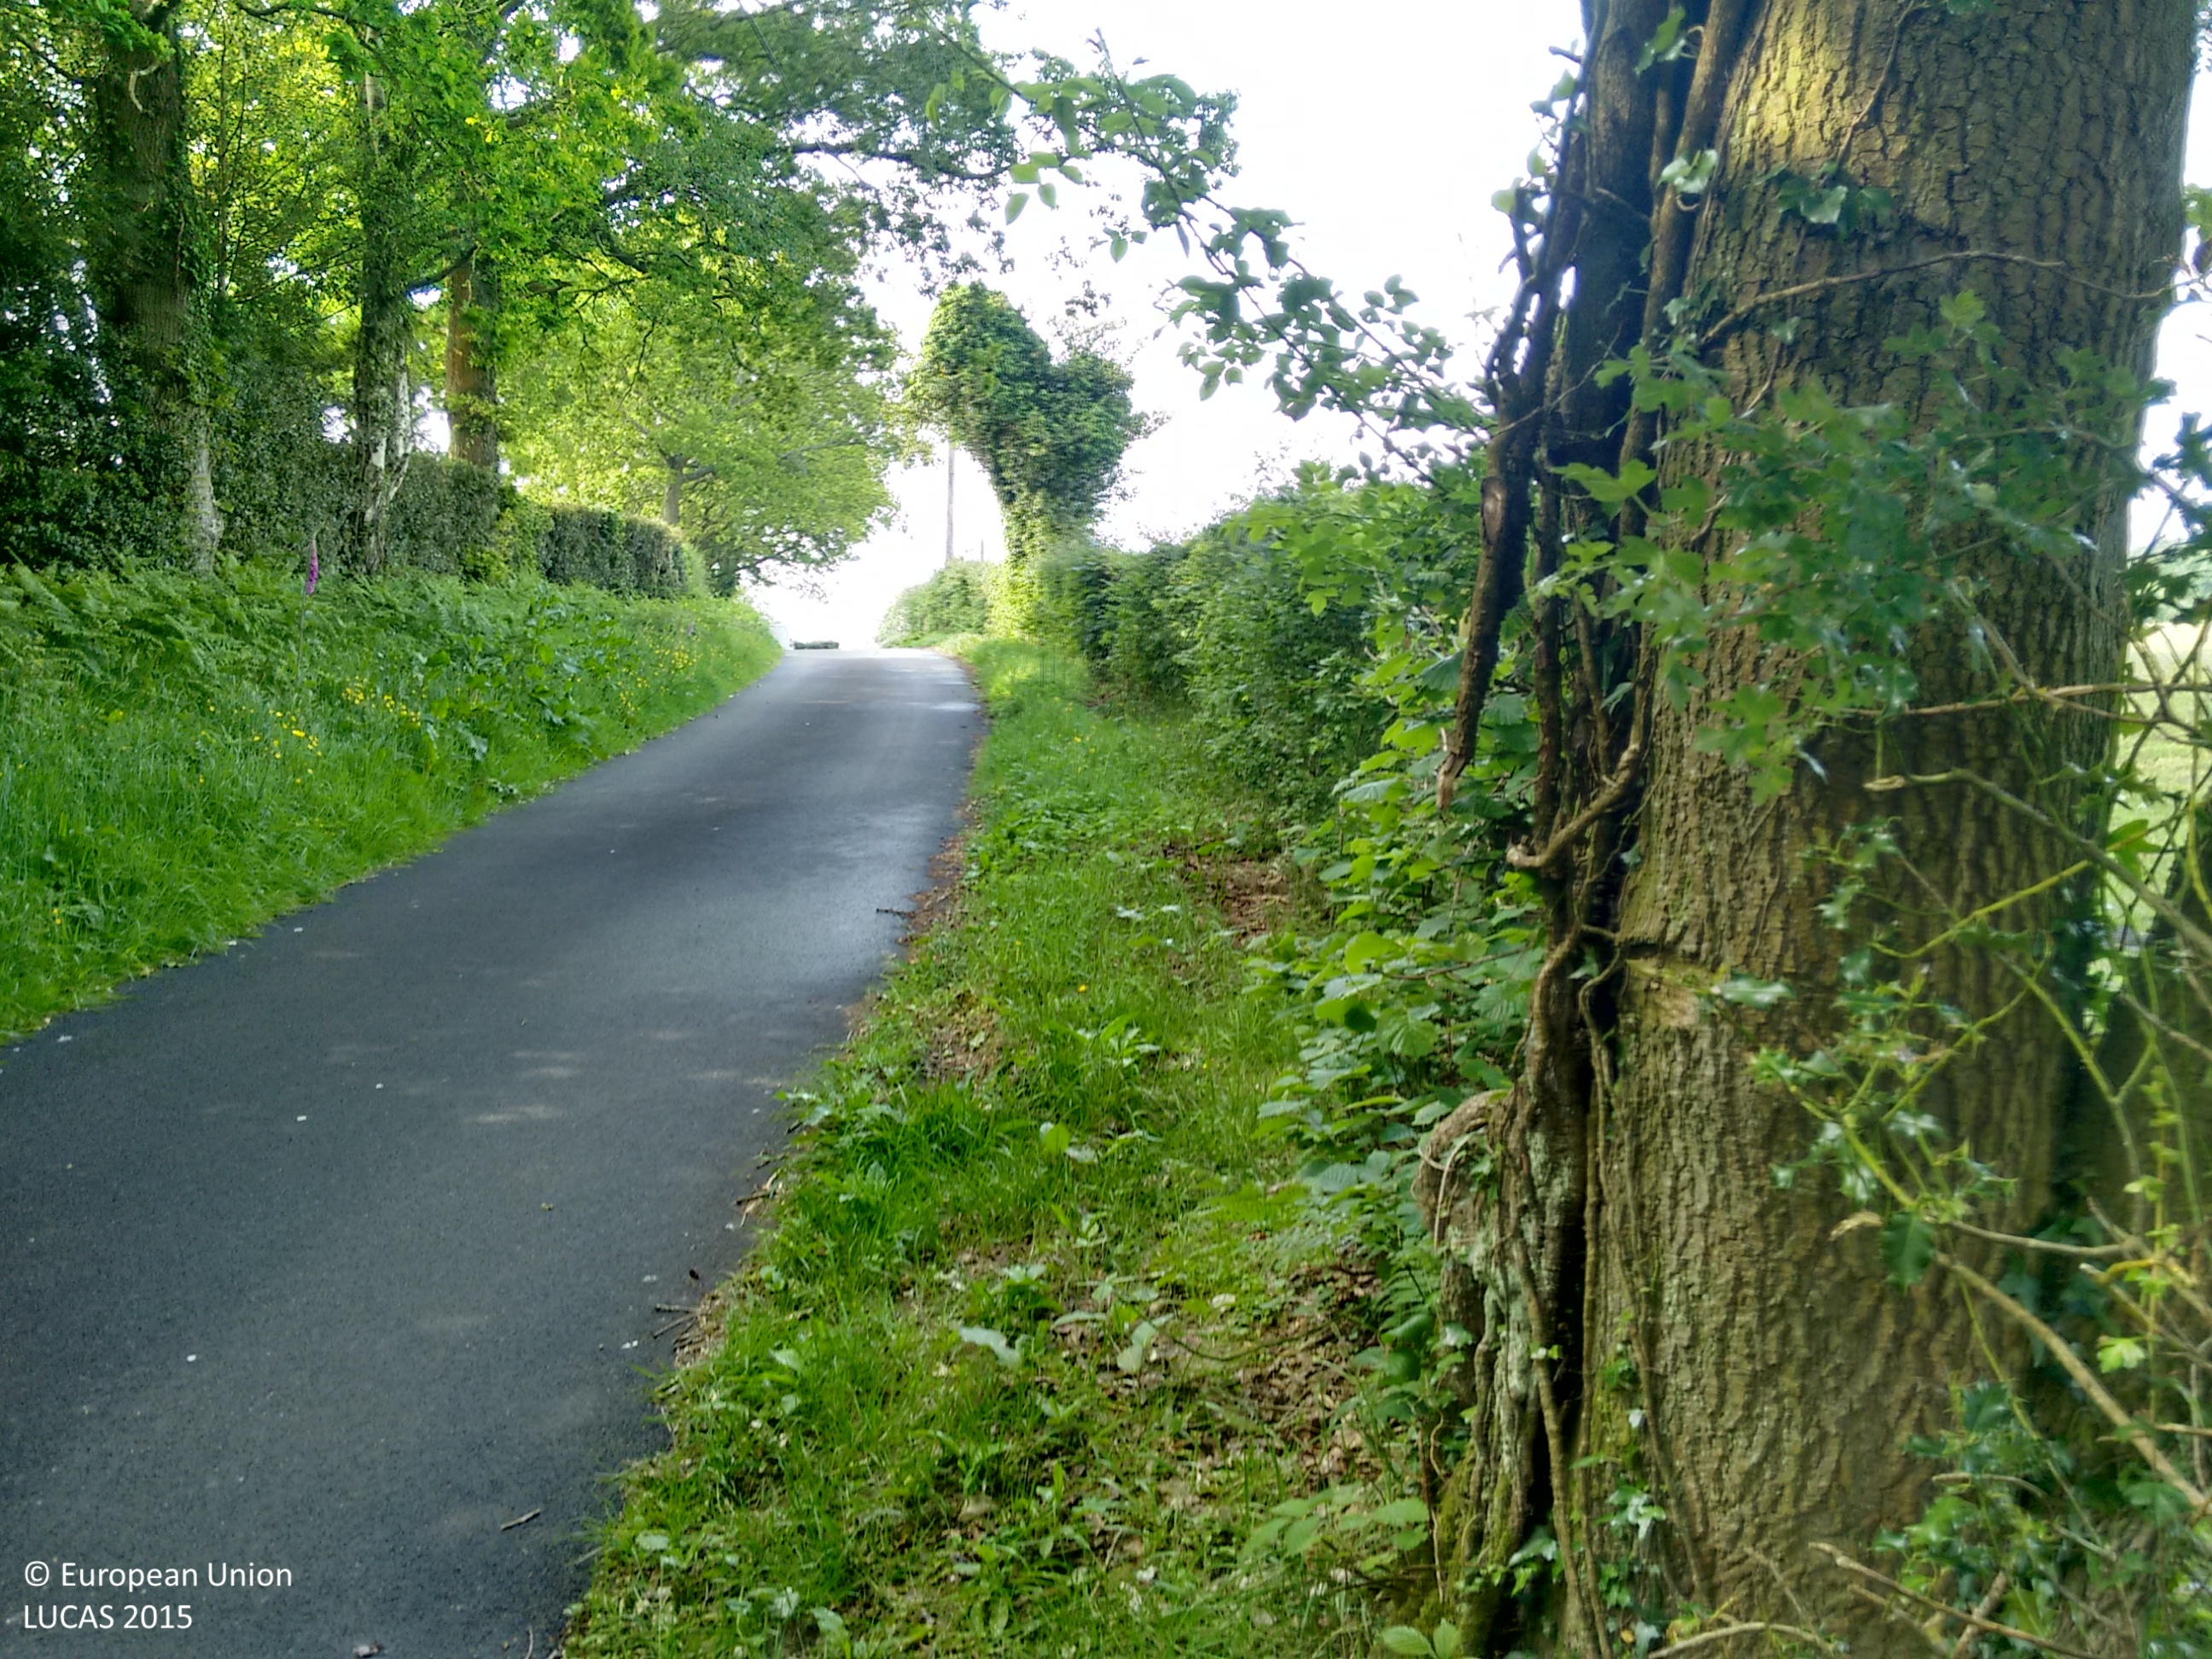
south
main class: Grassland
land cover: Grassland with sparse tree/shrub cover
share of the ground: > 75 %
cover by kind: herbaceous plants 95 %, broadleaved forest trees 5 %
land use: Agriculture (excluding fallow land and kitchen gardens)
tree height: > 5 m
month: June
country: GB
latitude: 50.9855
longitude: 0.3265
